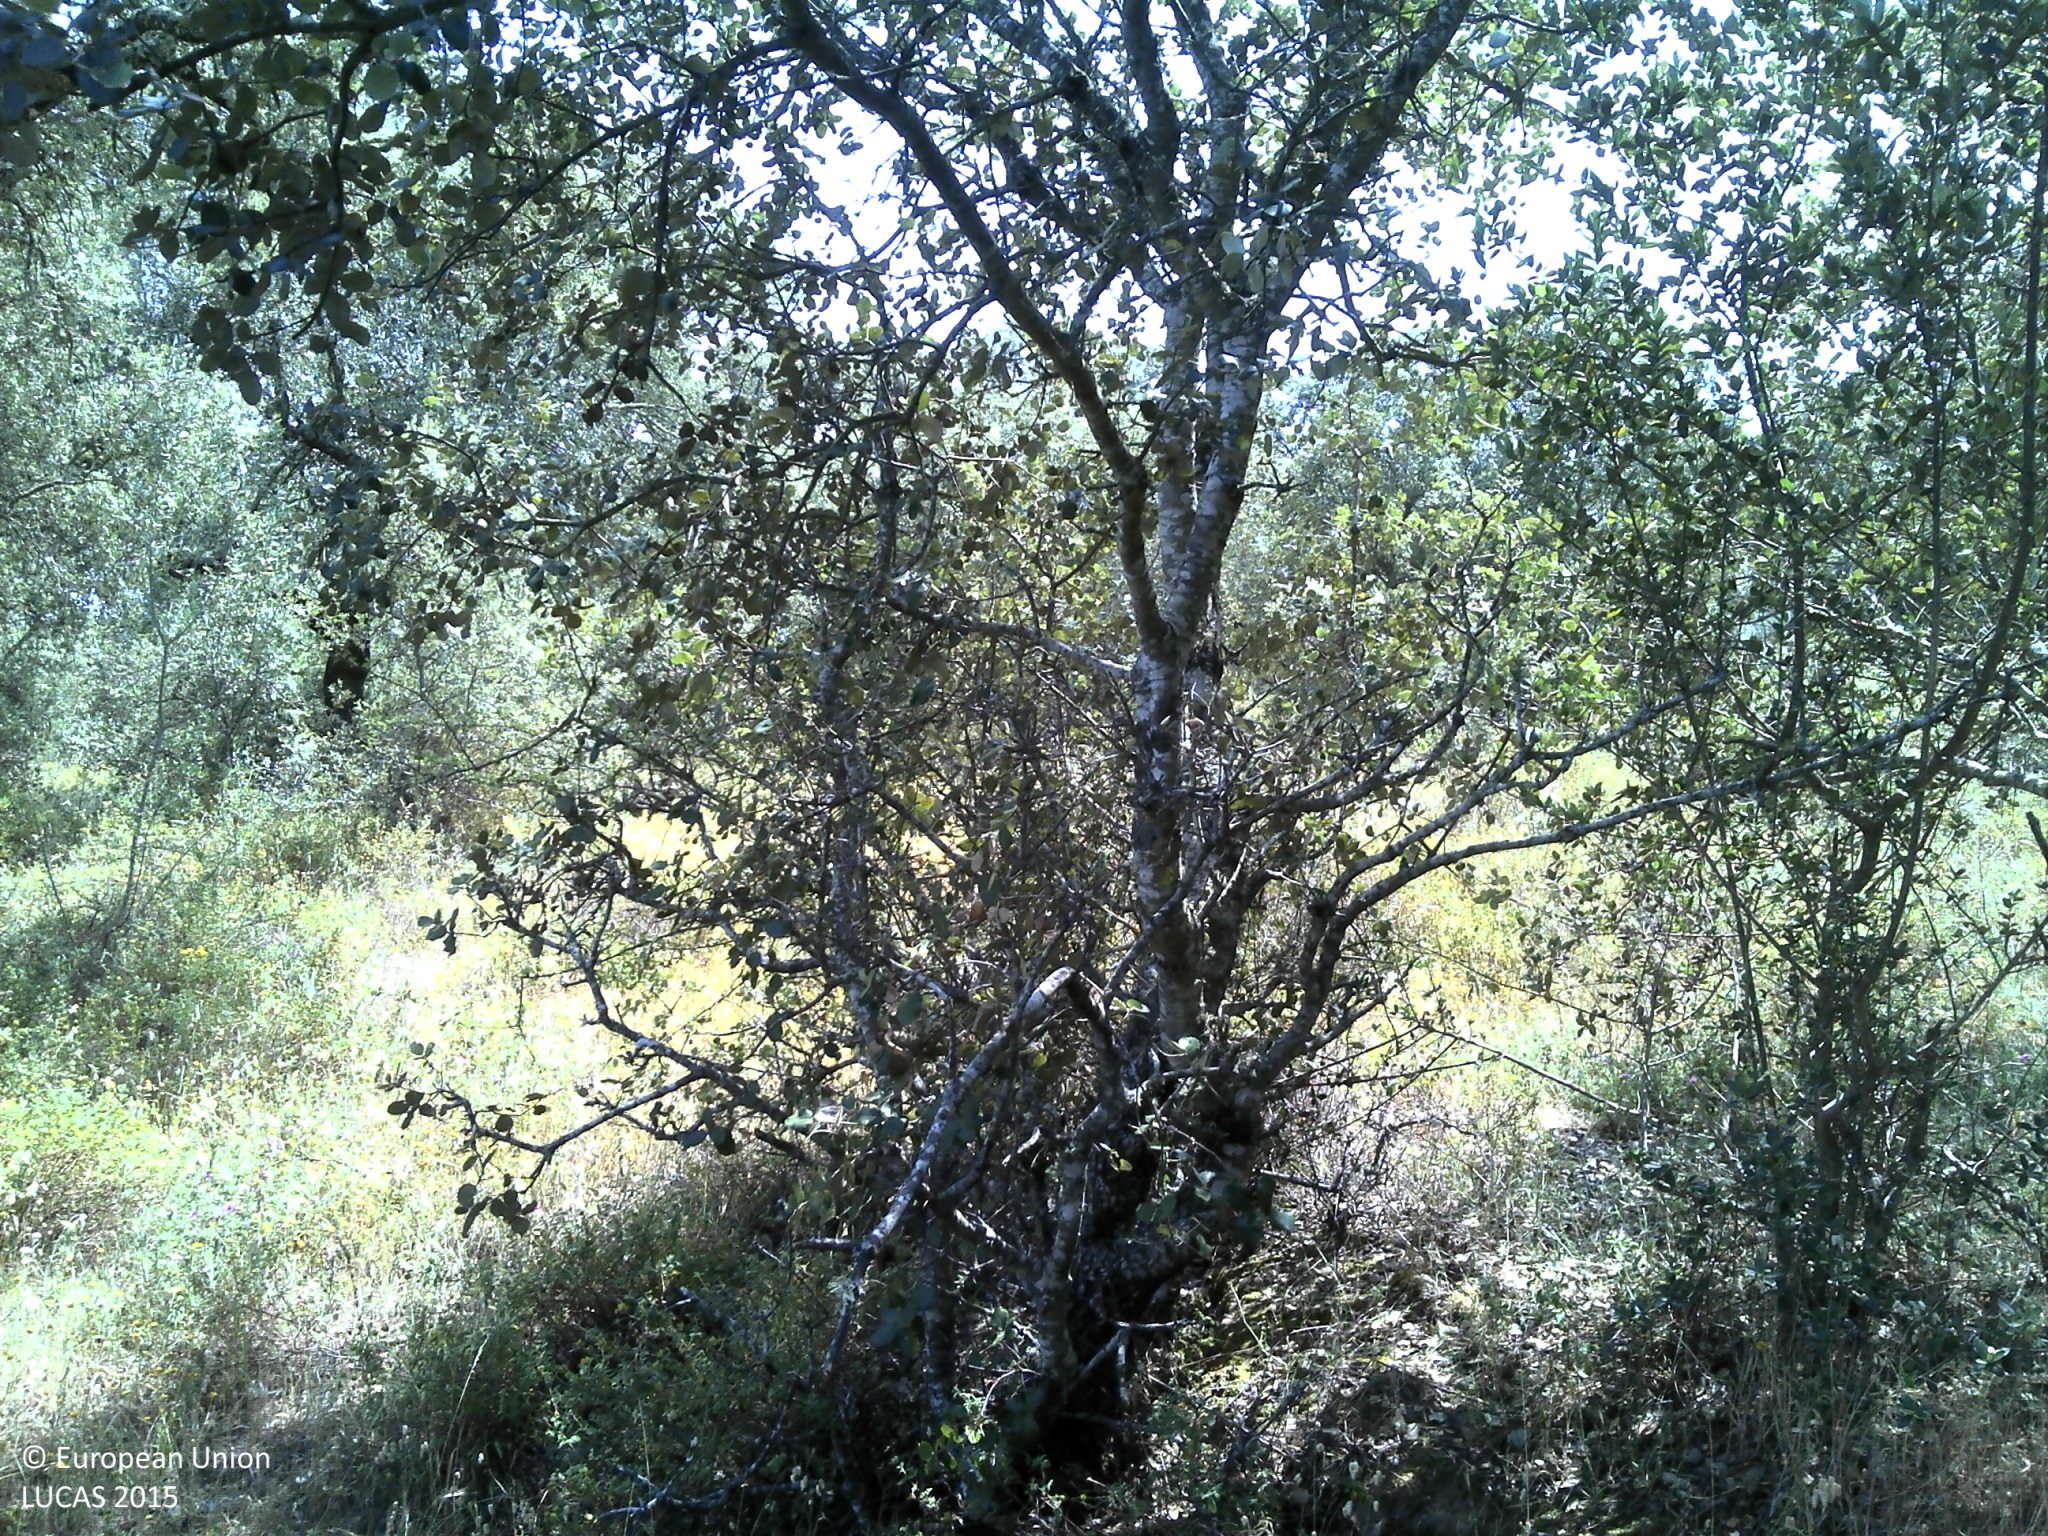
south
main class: Woodland
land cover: Broadleaved woodland
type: broadleaved evergreen forest
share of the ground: 50 - 75 %
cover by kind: broadleaved forest trees 60 %, shrubs 30 %, herbaceous plants 10 %
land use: Forestry
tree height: > 5 m
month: May
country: PT
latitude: 39.1743
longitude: -7.6266
